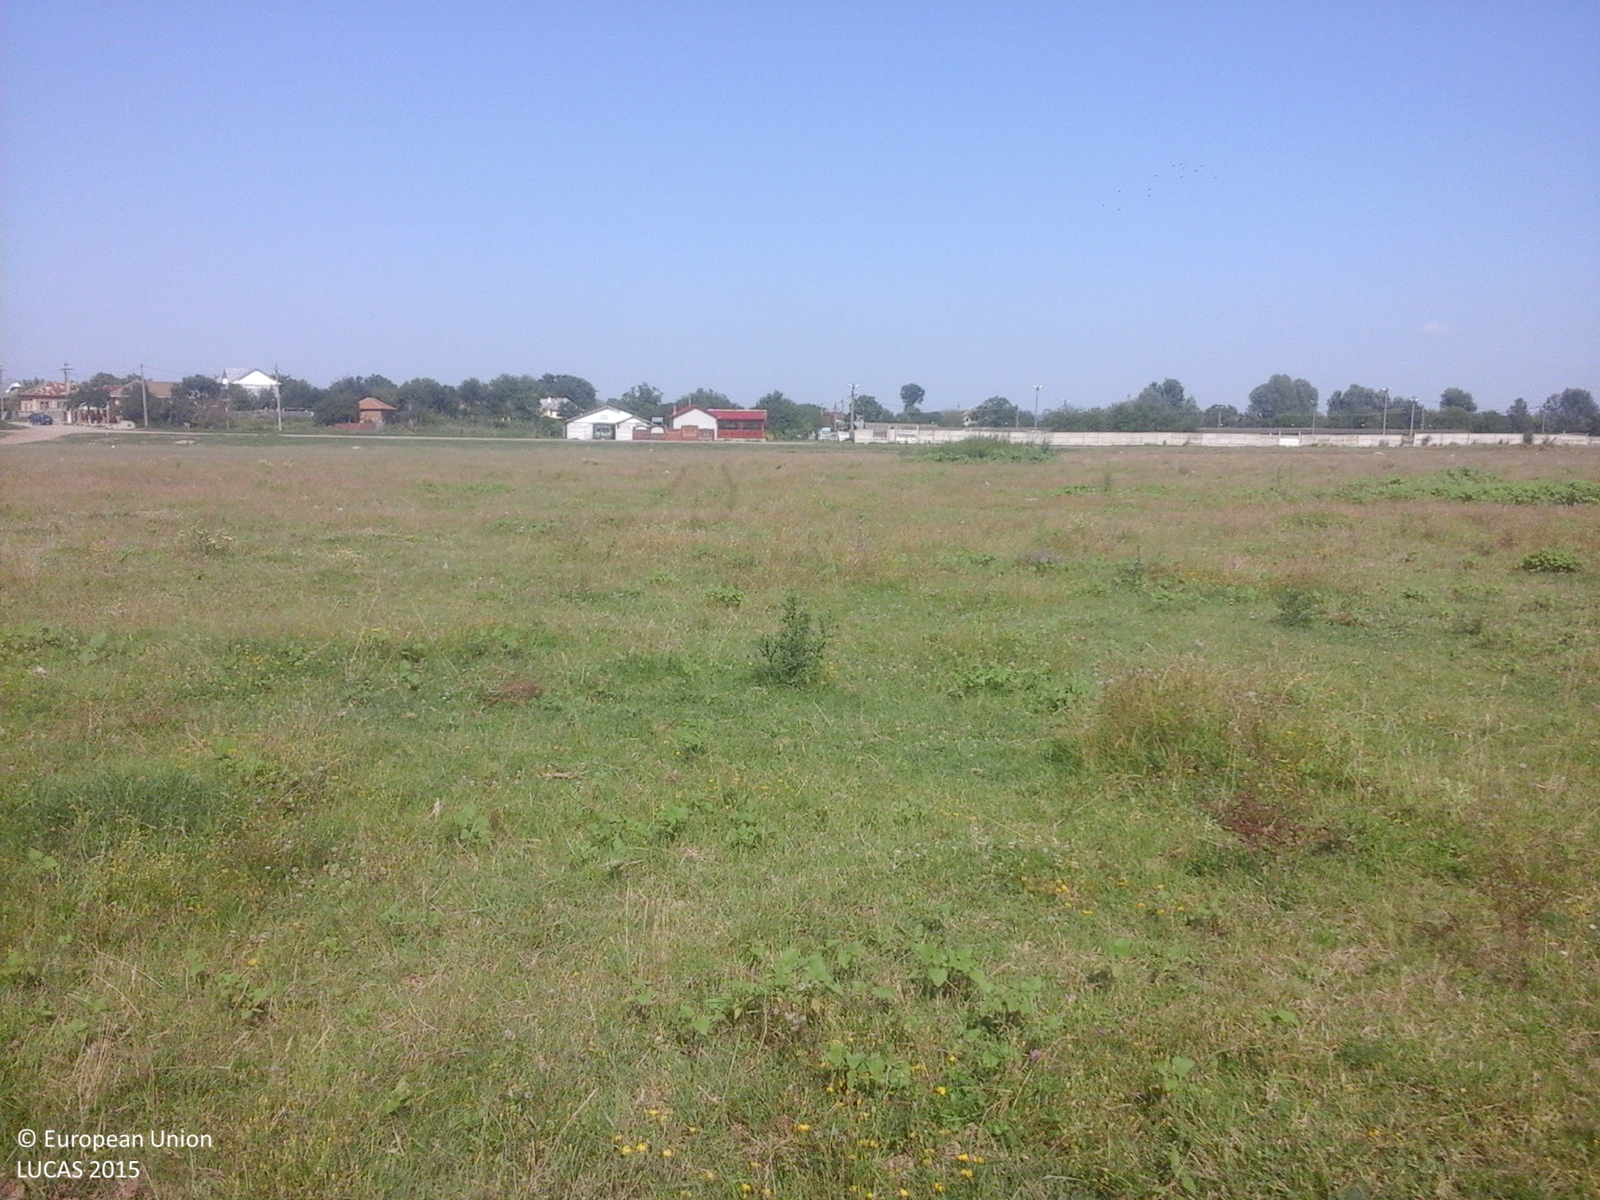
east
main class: Grassland
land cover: Grassland without tree/shrub cover
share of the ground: > 75 %
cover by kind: herbaceous plants 100 %
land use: Agriculture (excluding fallow land and kitchen gardens)
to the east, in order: Grassland without tree/shrub cover; Tracks; Grass margins; Tracks
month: July
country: RO
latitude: 44.2500
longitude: 24.3044
